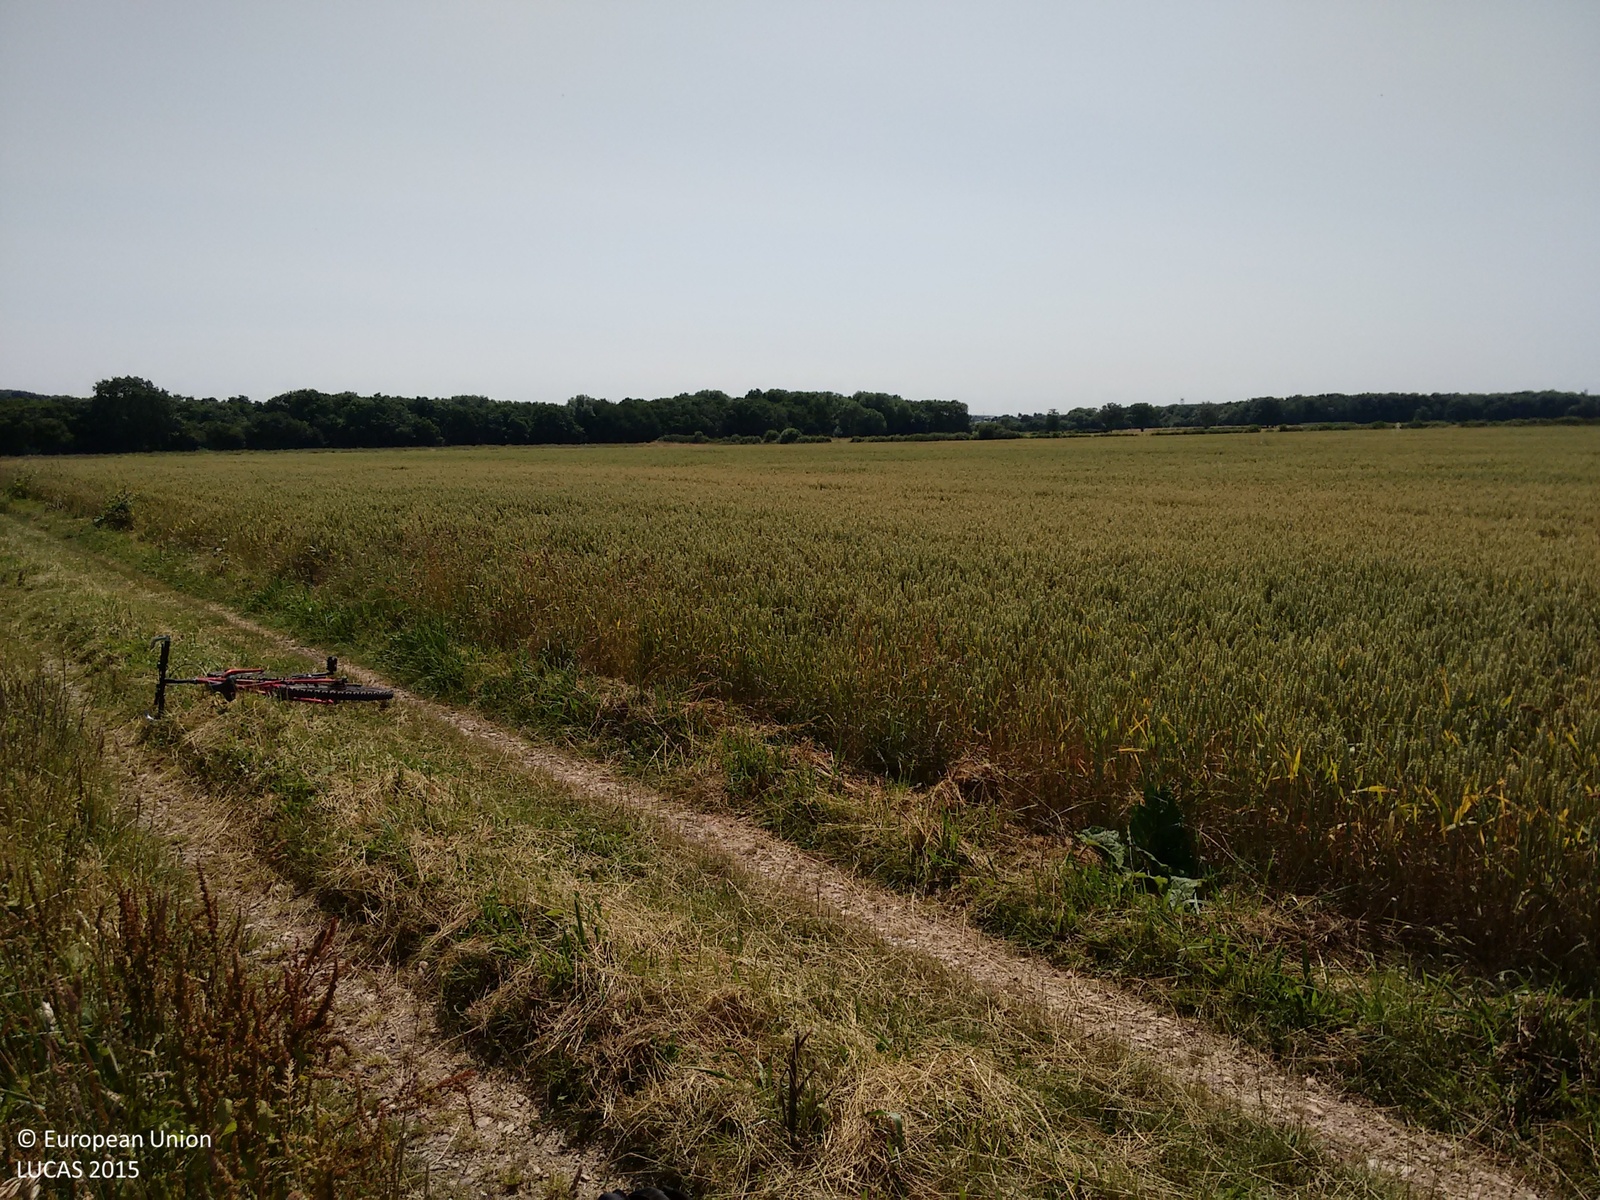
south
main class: Cropland
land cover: Common wheat
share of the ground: > 75 %
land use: Agriculture (excluding fallow land and kitchen gardens)
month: July
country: GB
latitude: 53.2469
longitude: -0.9682
